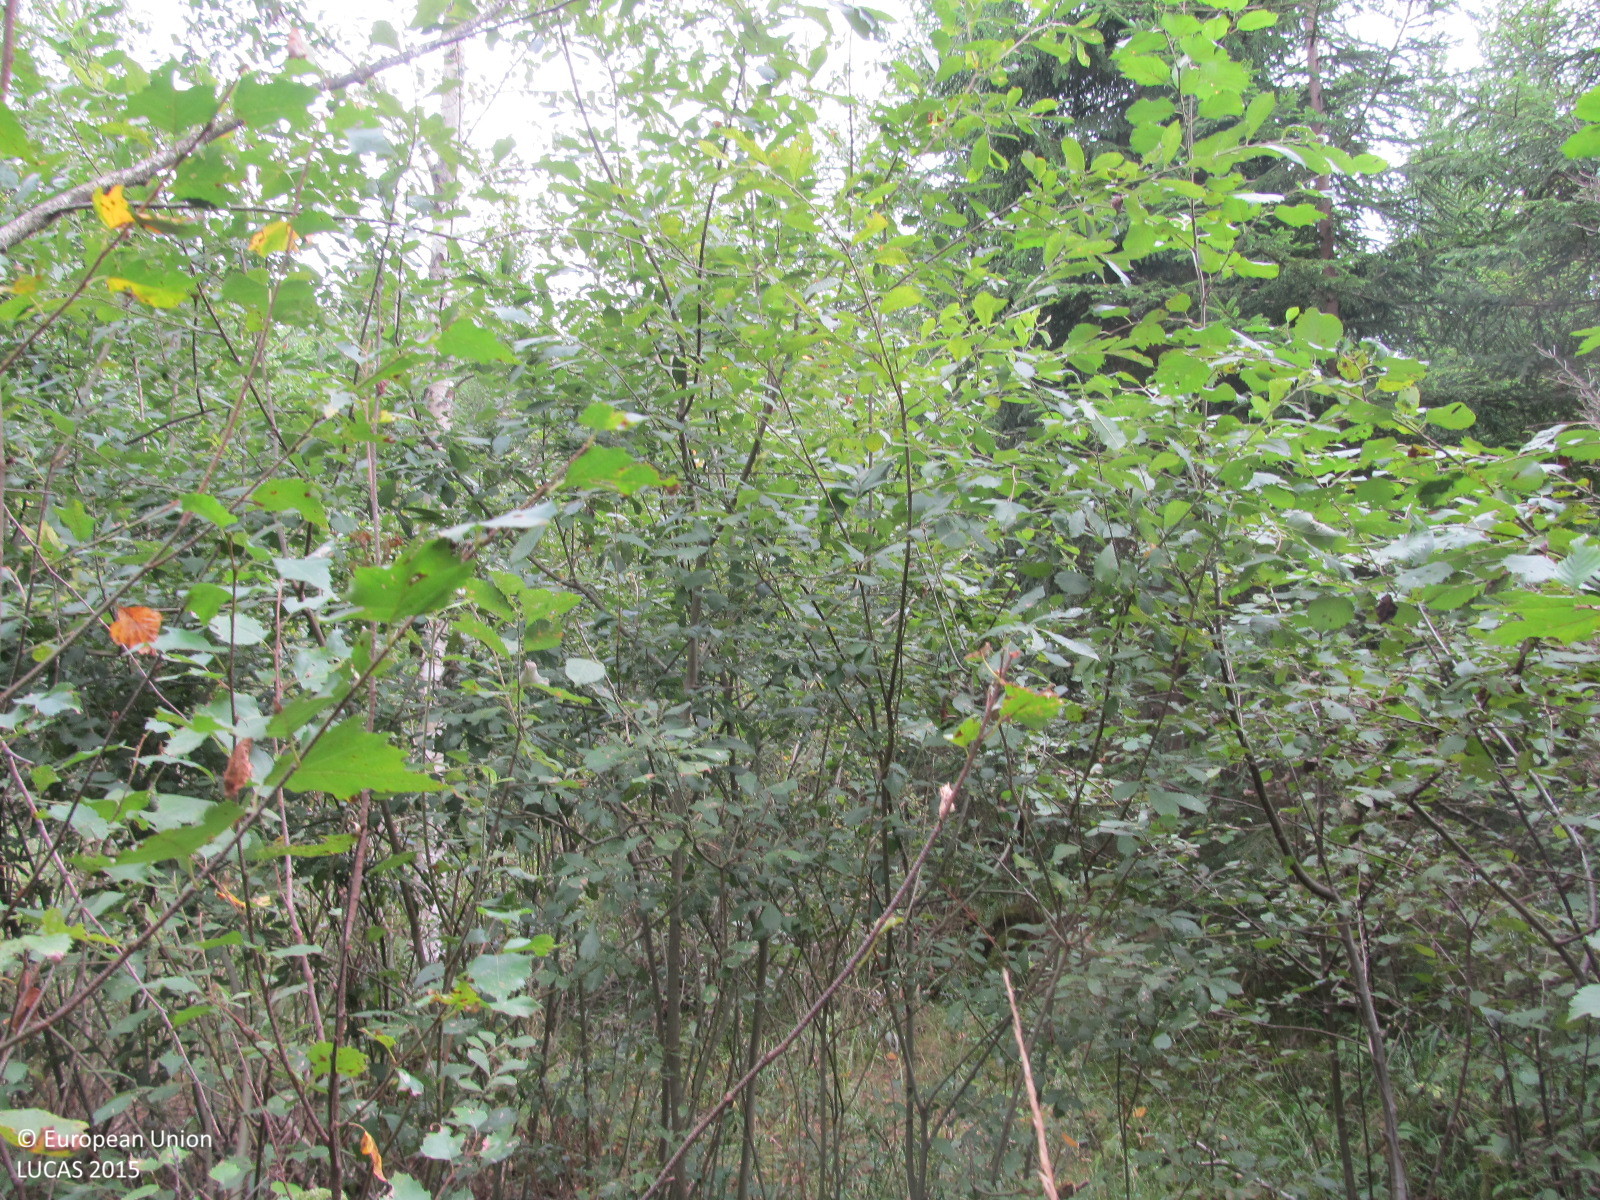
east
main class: Woodland
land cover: Spruce dominated mixed woodland
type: hemiboreal forest and nemoral coniferous forest and mixed broadleaved-coniferous forest
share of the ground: > 75 %
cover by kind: coniferous forest trees 50 %, broadleaved forest trees 30 %, shrubs 10 %, herbaceous plants 5 %, lichens and mosses 5 %
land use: Forestry
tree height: > 5 m
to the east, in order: Spruce dominated mixed woodland; Tracks; Spruce dominated mixed woodland; Ditches and canals; Spruce dominated mixed woodland; Shrubland with sparse tree cover; Tracks; Spruce dominated mixed woodland
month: September
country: LT
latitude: 56.2862
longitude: 23.2040
